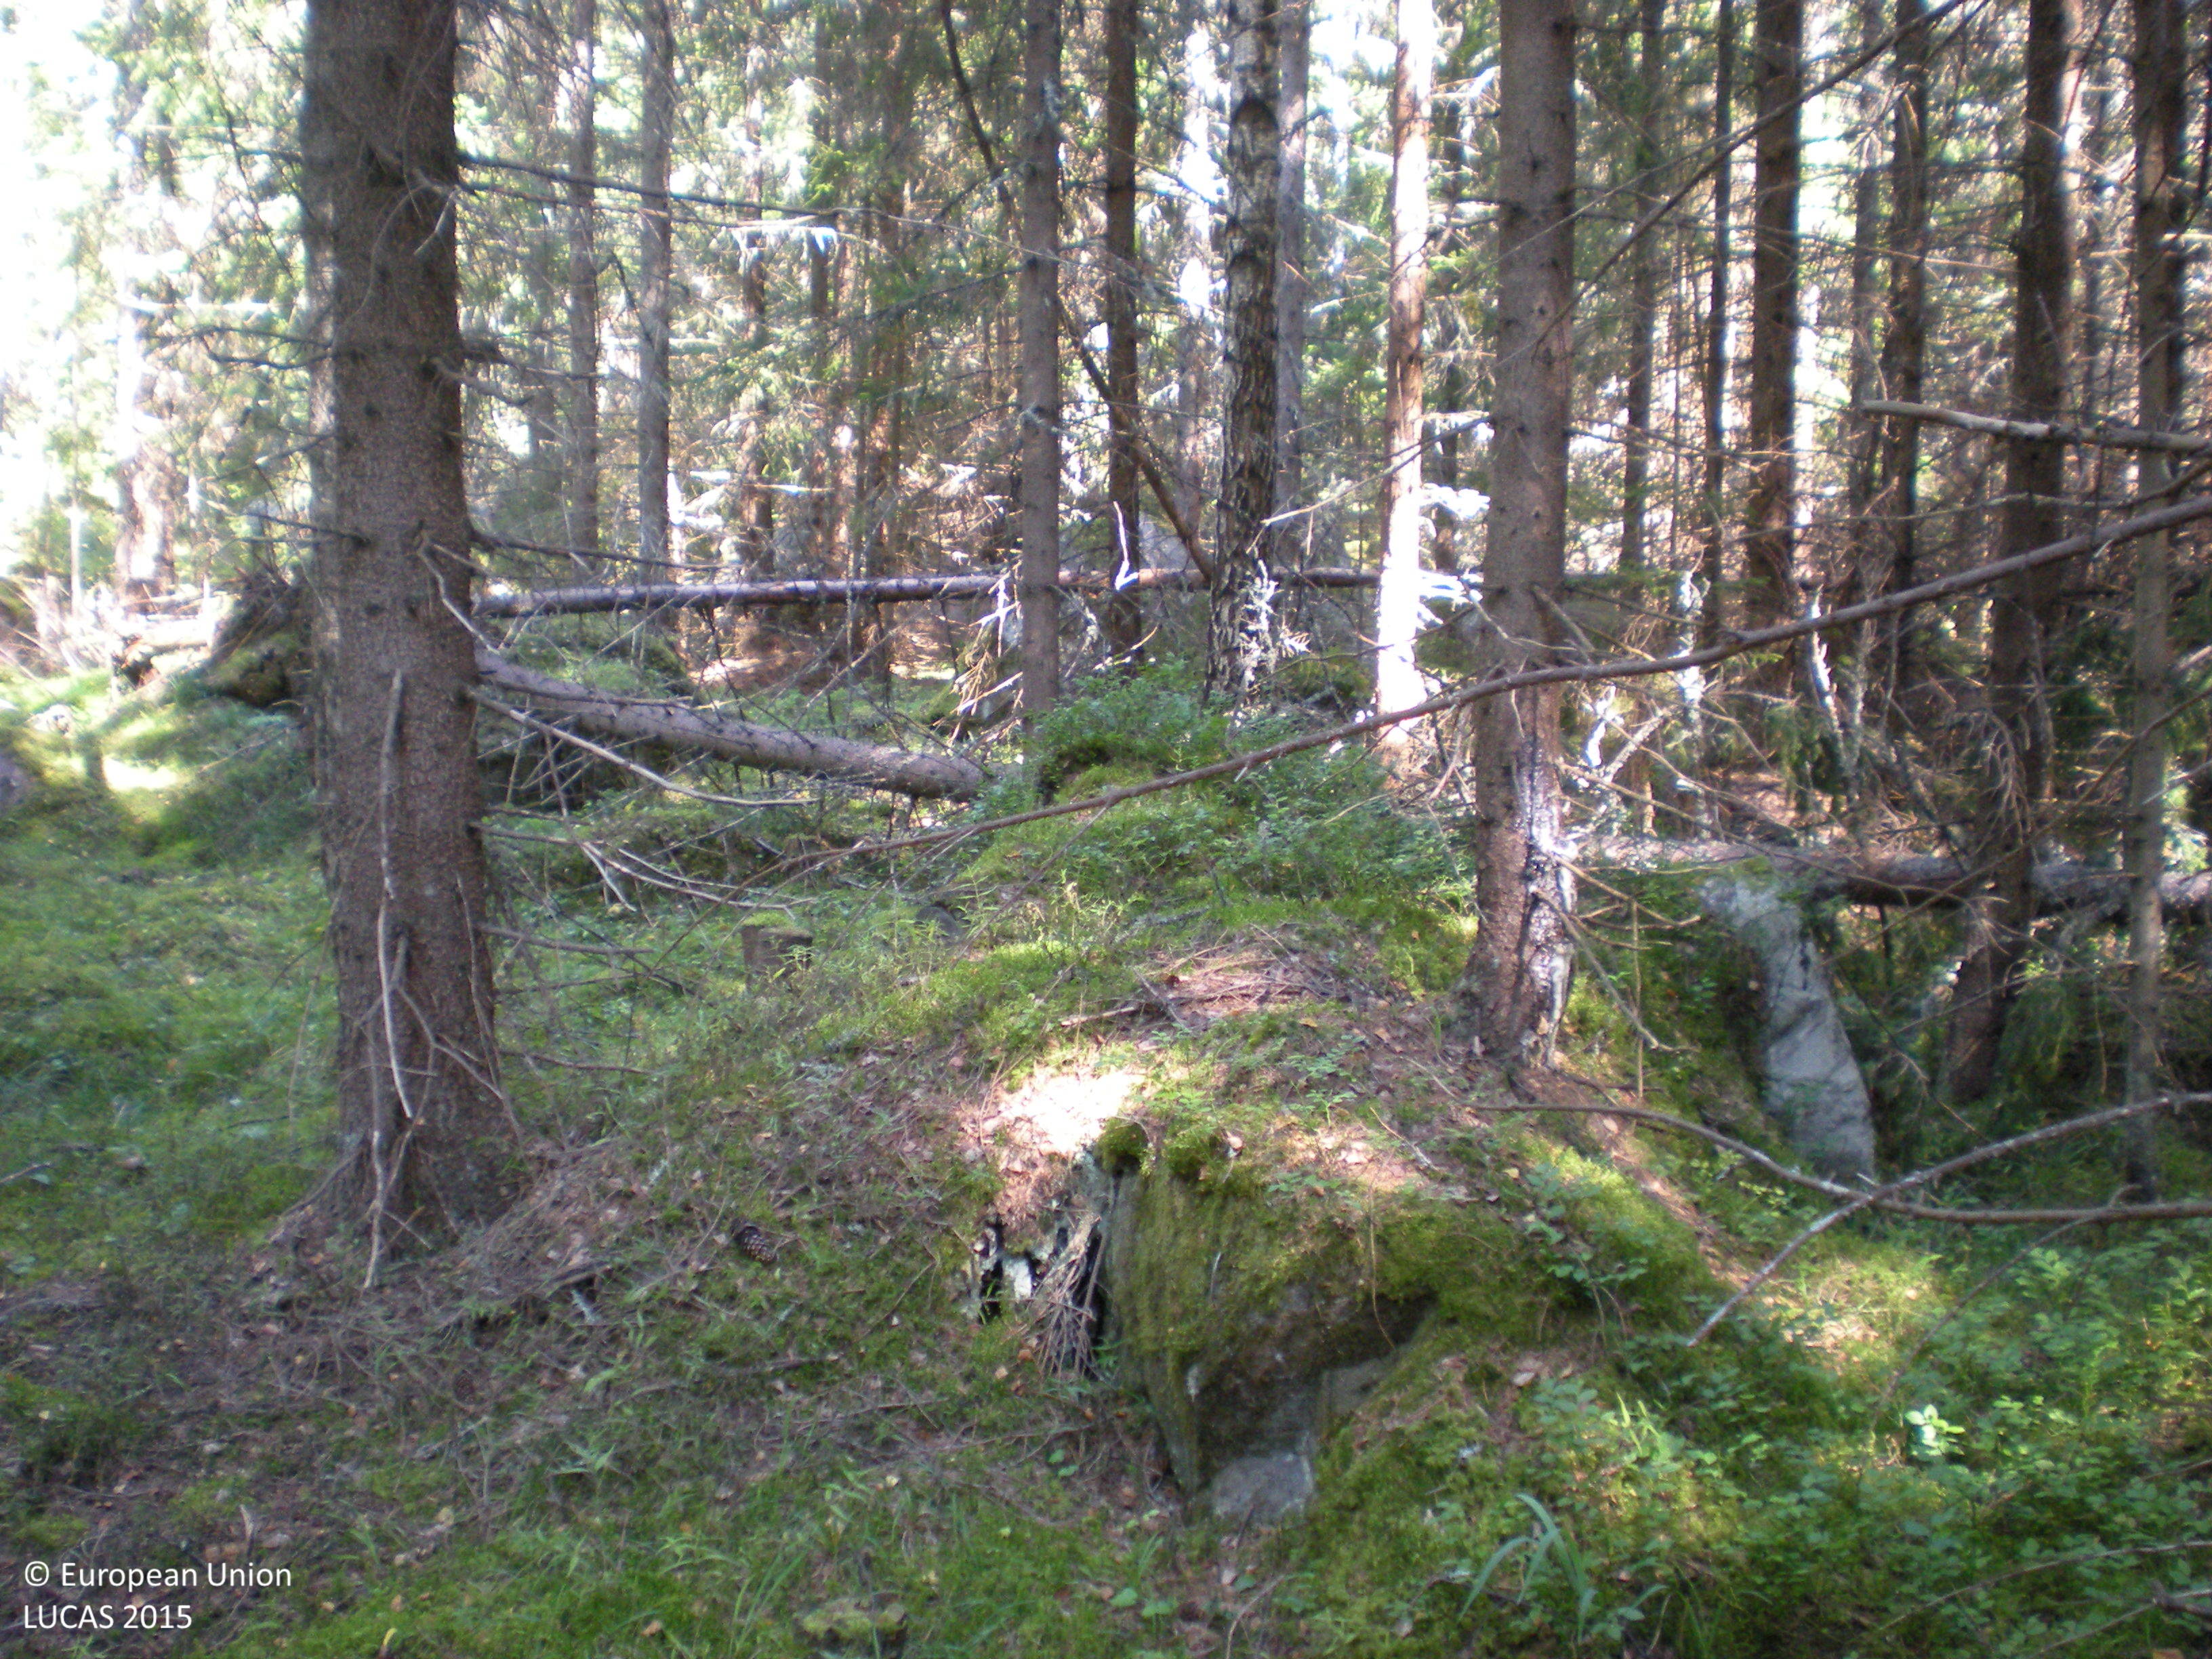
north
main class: Woodland
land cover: Spruce dominated coniferous woodland
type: boreal forest
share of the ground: > 75 %
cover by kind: coniferous forest trees 80 %, lichens and mosses 10 %, broadleaved forest trees 5 %, shrubs 5 %
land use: Forestry
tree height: > 5 m
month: August
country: SE
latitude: 60.6246
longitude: 17.6483
